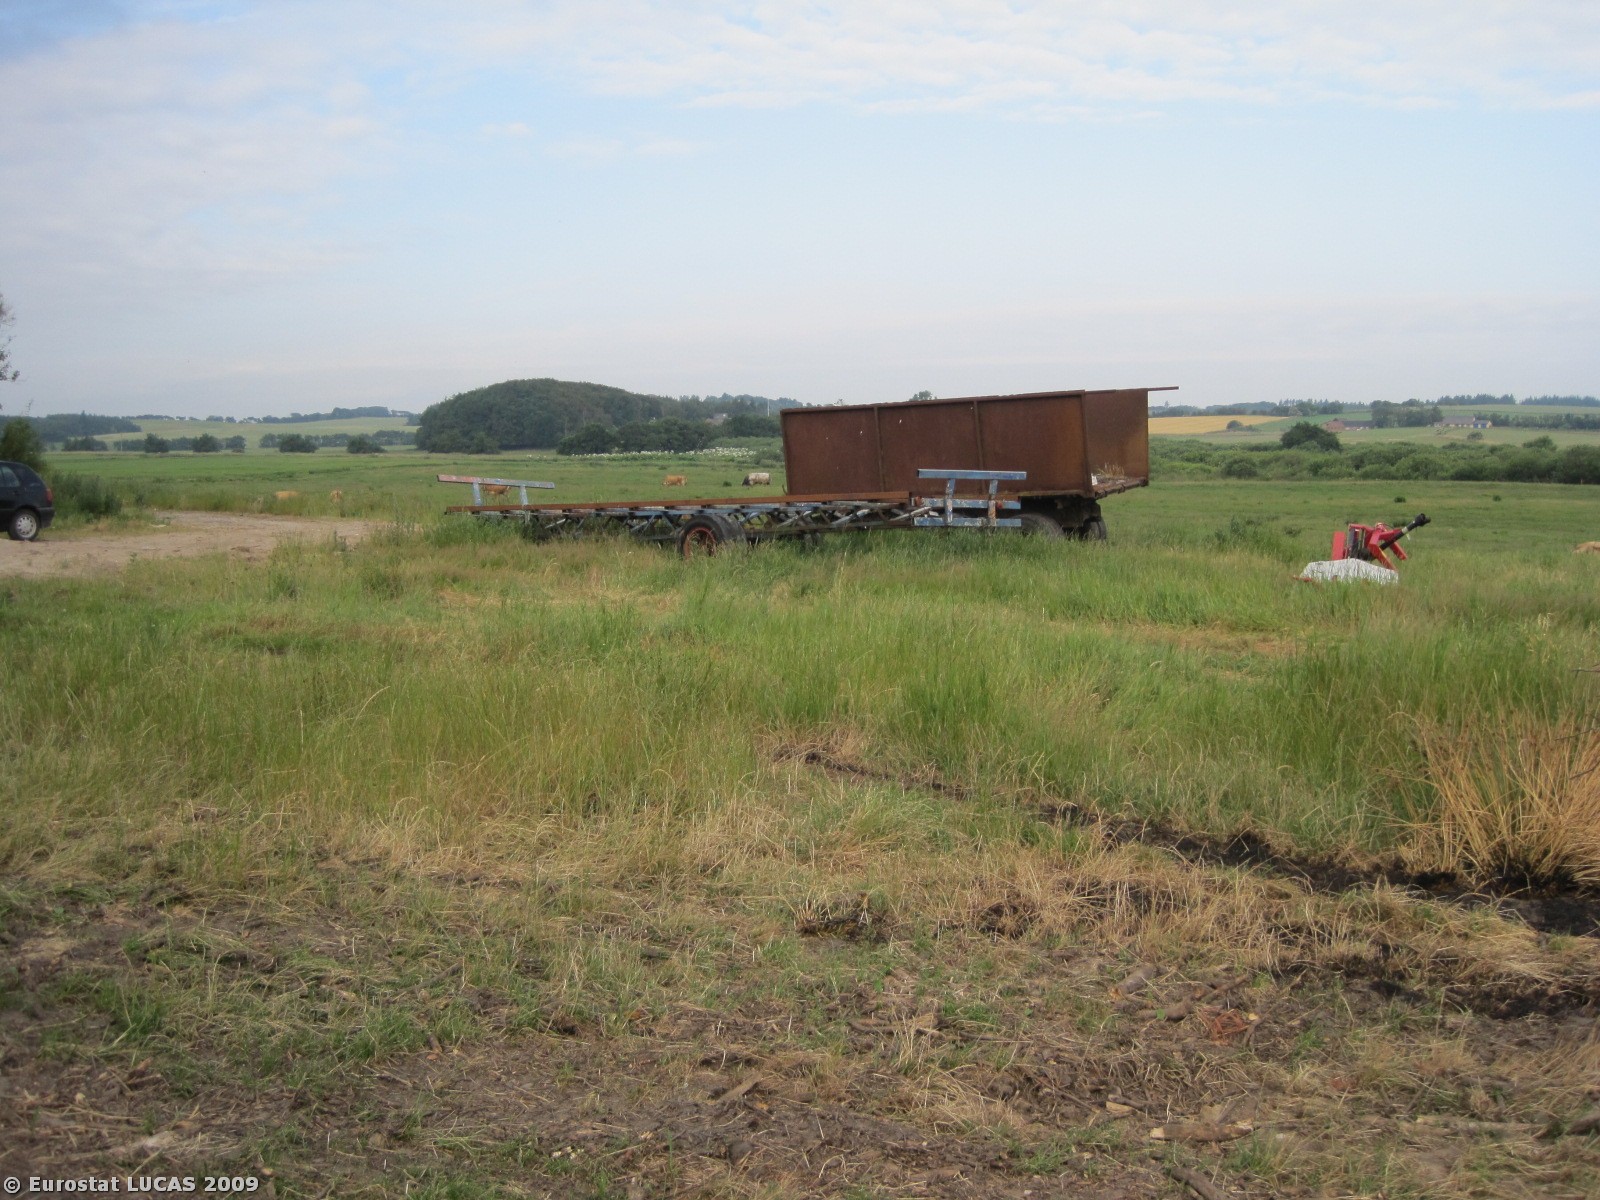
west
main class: Grassland
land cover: Grassland without tree/shrub cover
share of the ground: > 75 %
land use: Agriculture (excluding fallow land and kitchen gardens)
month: June
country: DK
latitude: 56.5385
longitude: 8.4895
